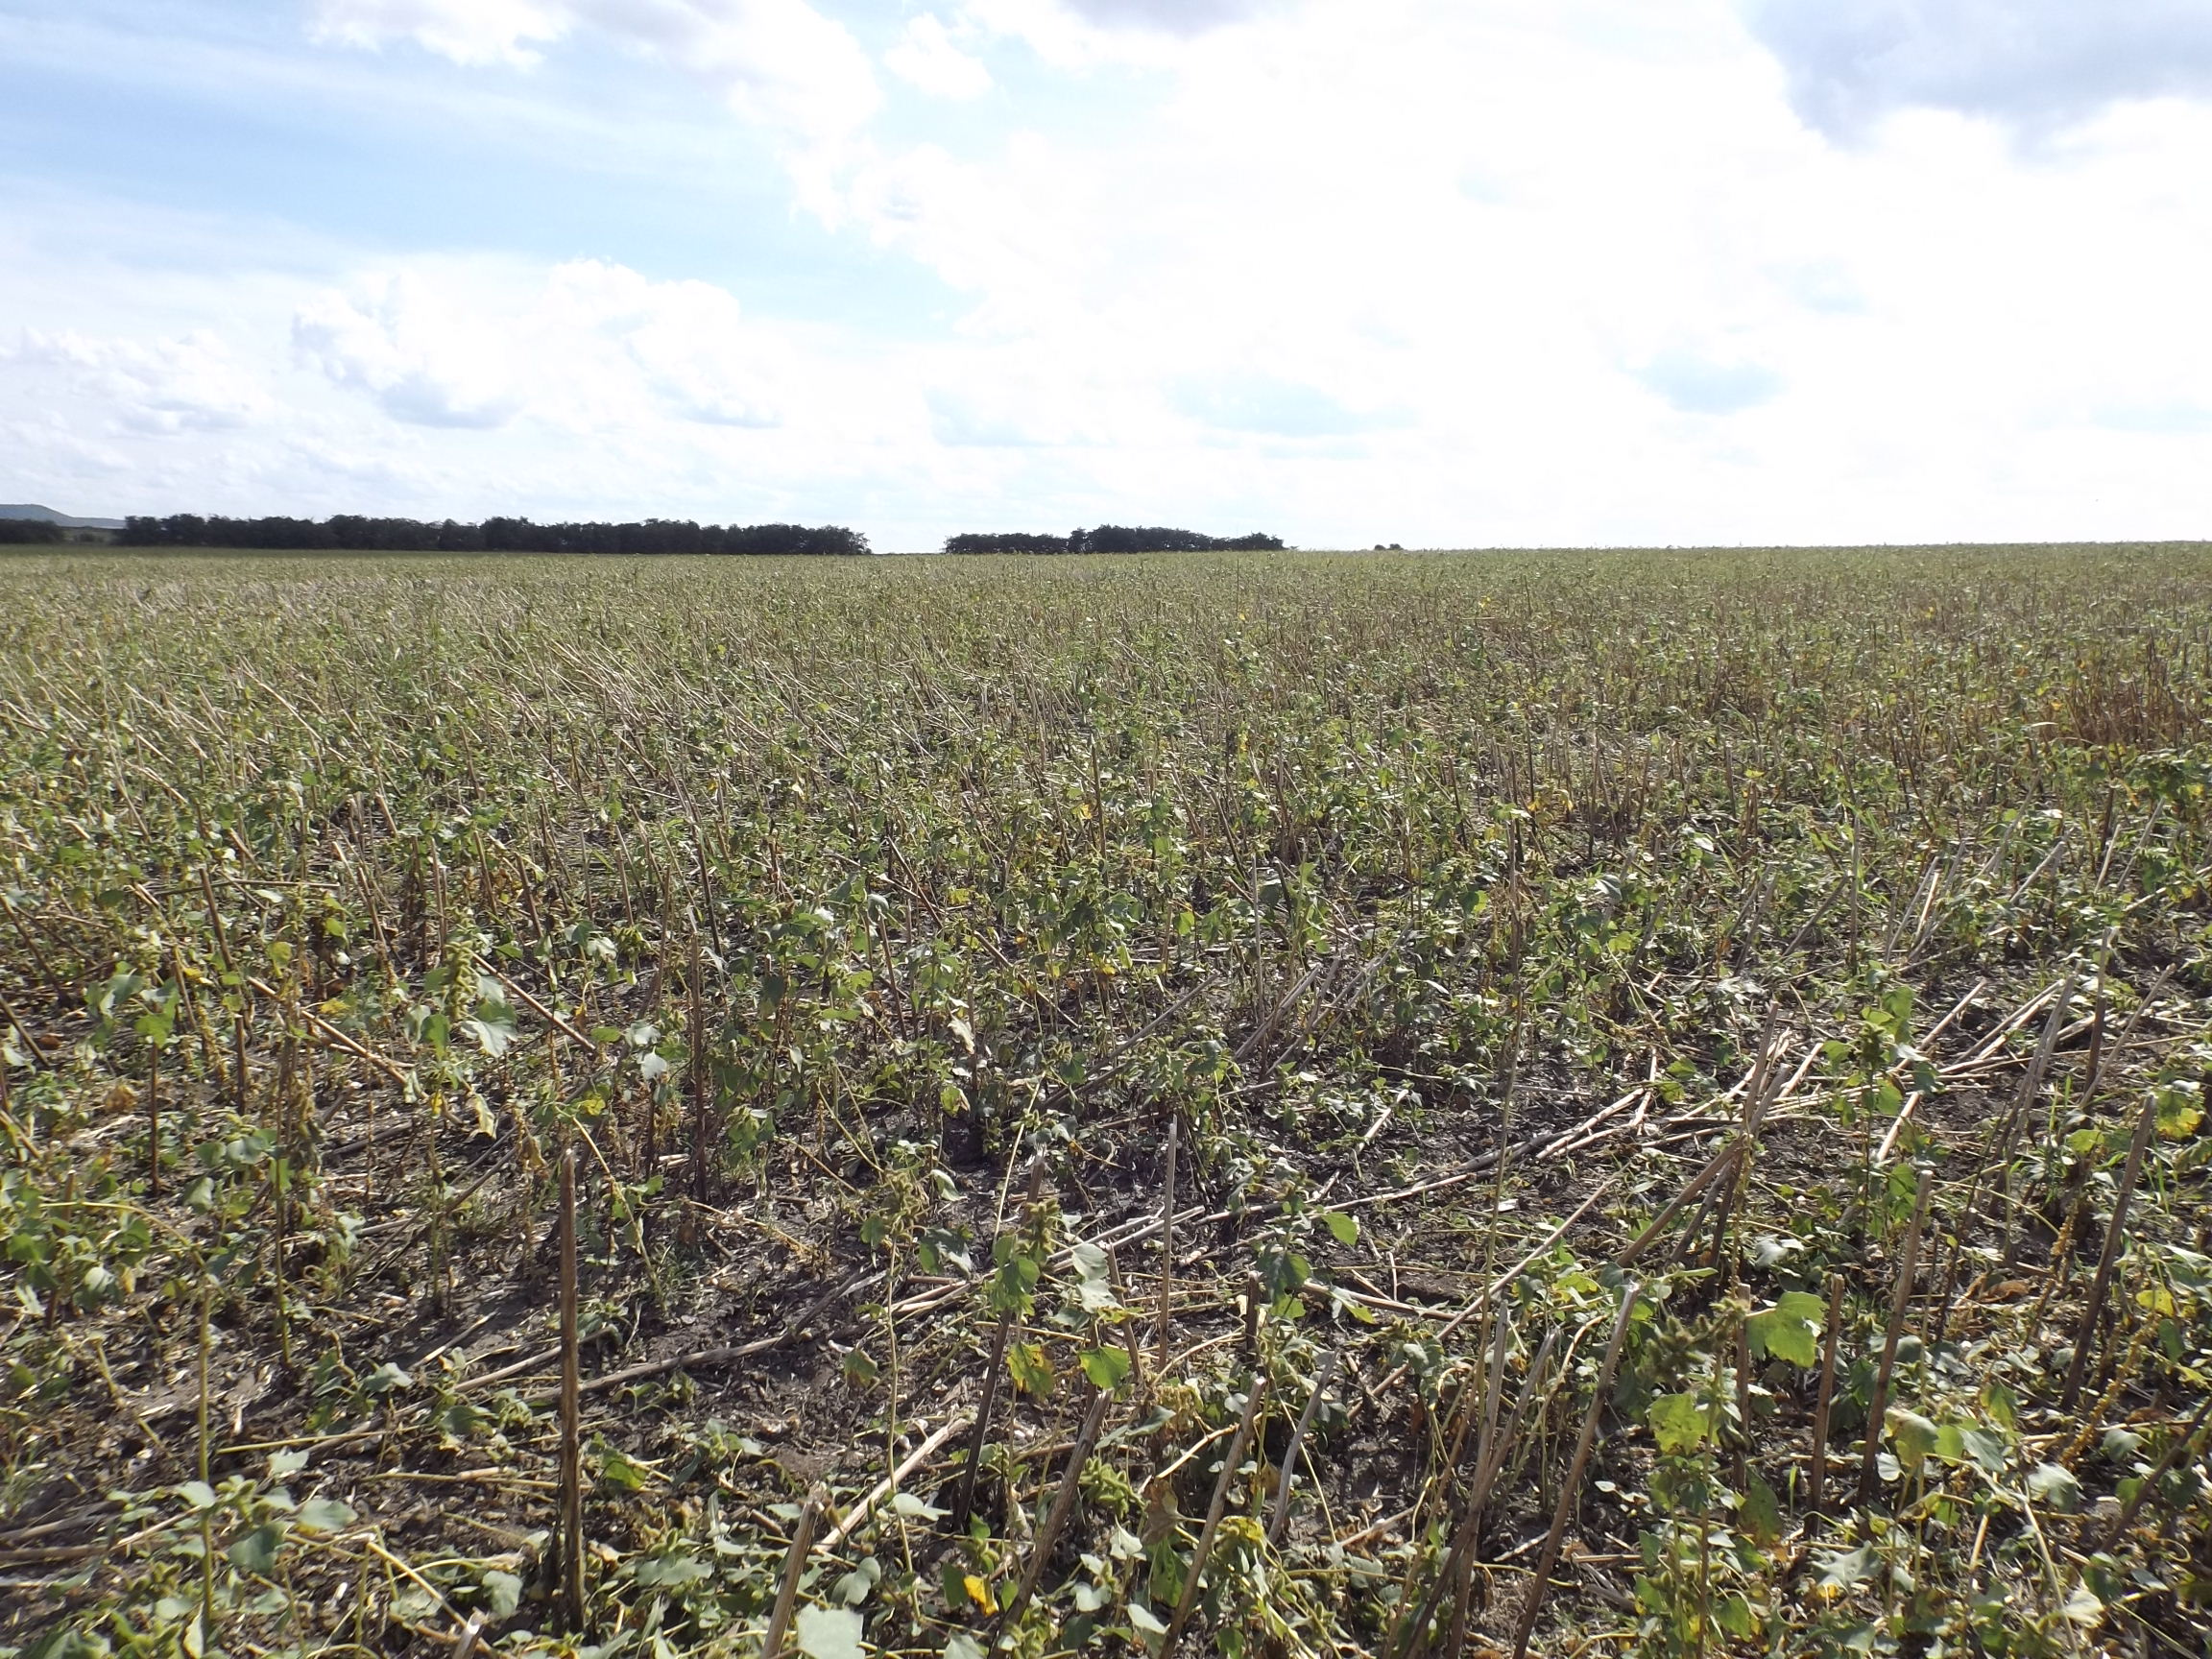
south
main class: Cropland
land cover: Sunflower
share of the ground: < 10 %
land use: Agriculture (excluding fallow land and kitchen gardens)
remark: Harvested field
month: September
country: BG
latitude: 43.2832
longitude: 27.4411
